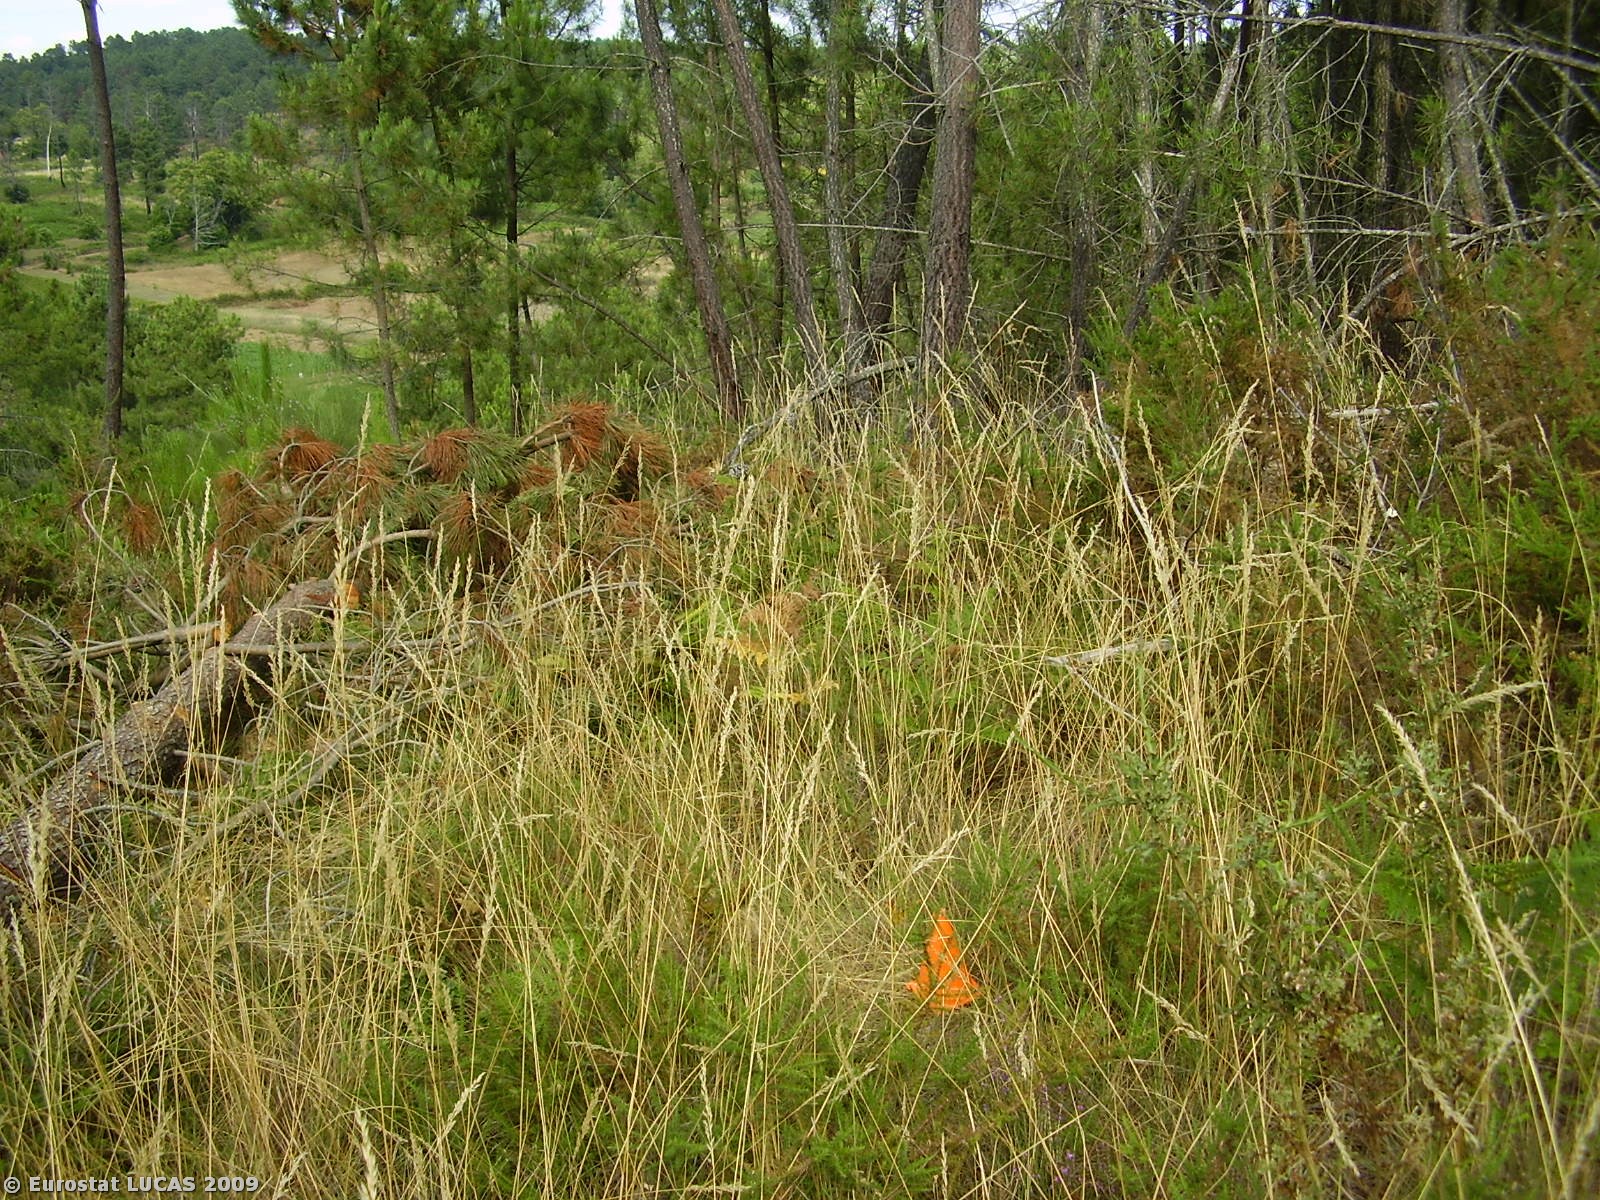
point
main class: Woodland
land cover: Coniferous woodland
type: coniferous forest of the mediterranean region
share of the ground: 50 - 75 %
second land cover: Spontaneously vegetated surfaces
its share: 10 - 25 %
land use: Forestry
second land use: Unused
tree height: > 5 m
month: July
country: PT
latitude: 41.2405
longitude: -7.6308
